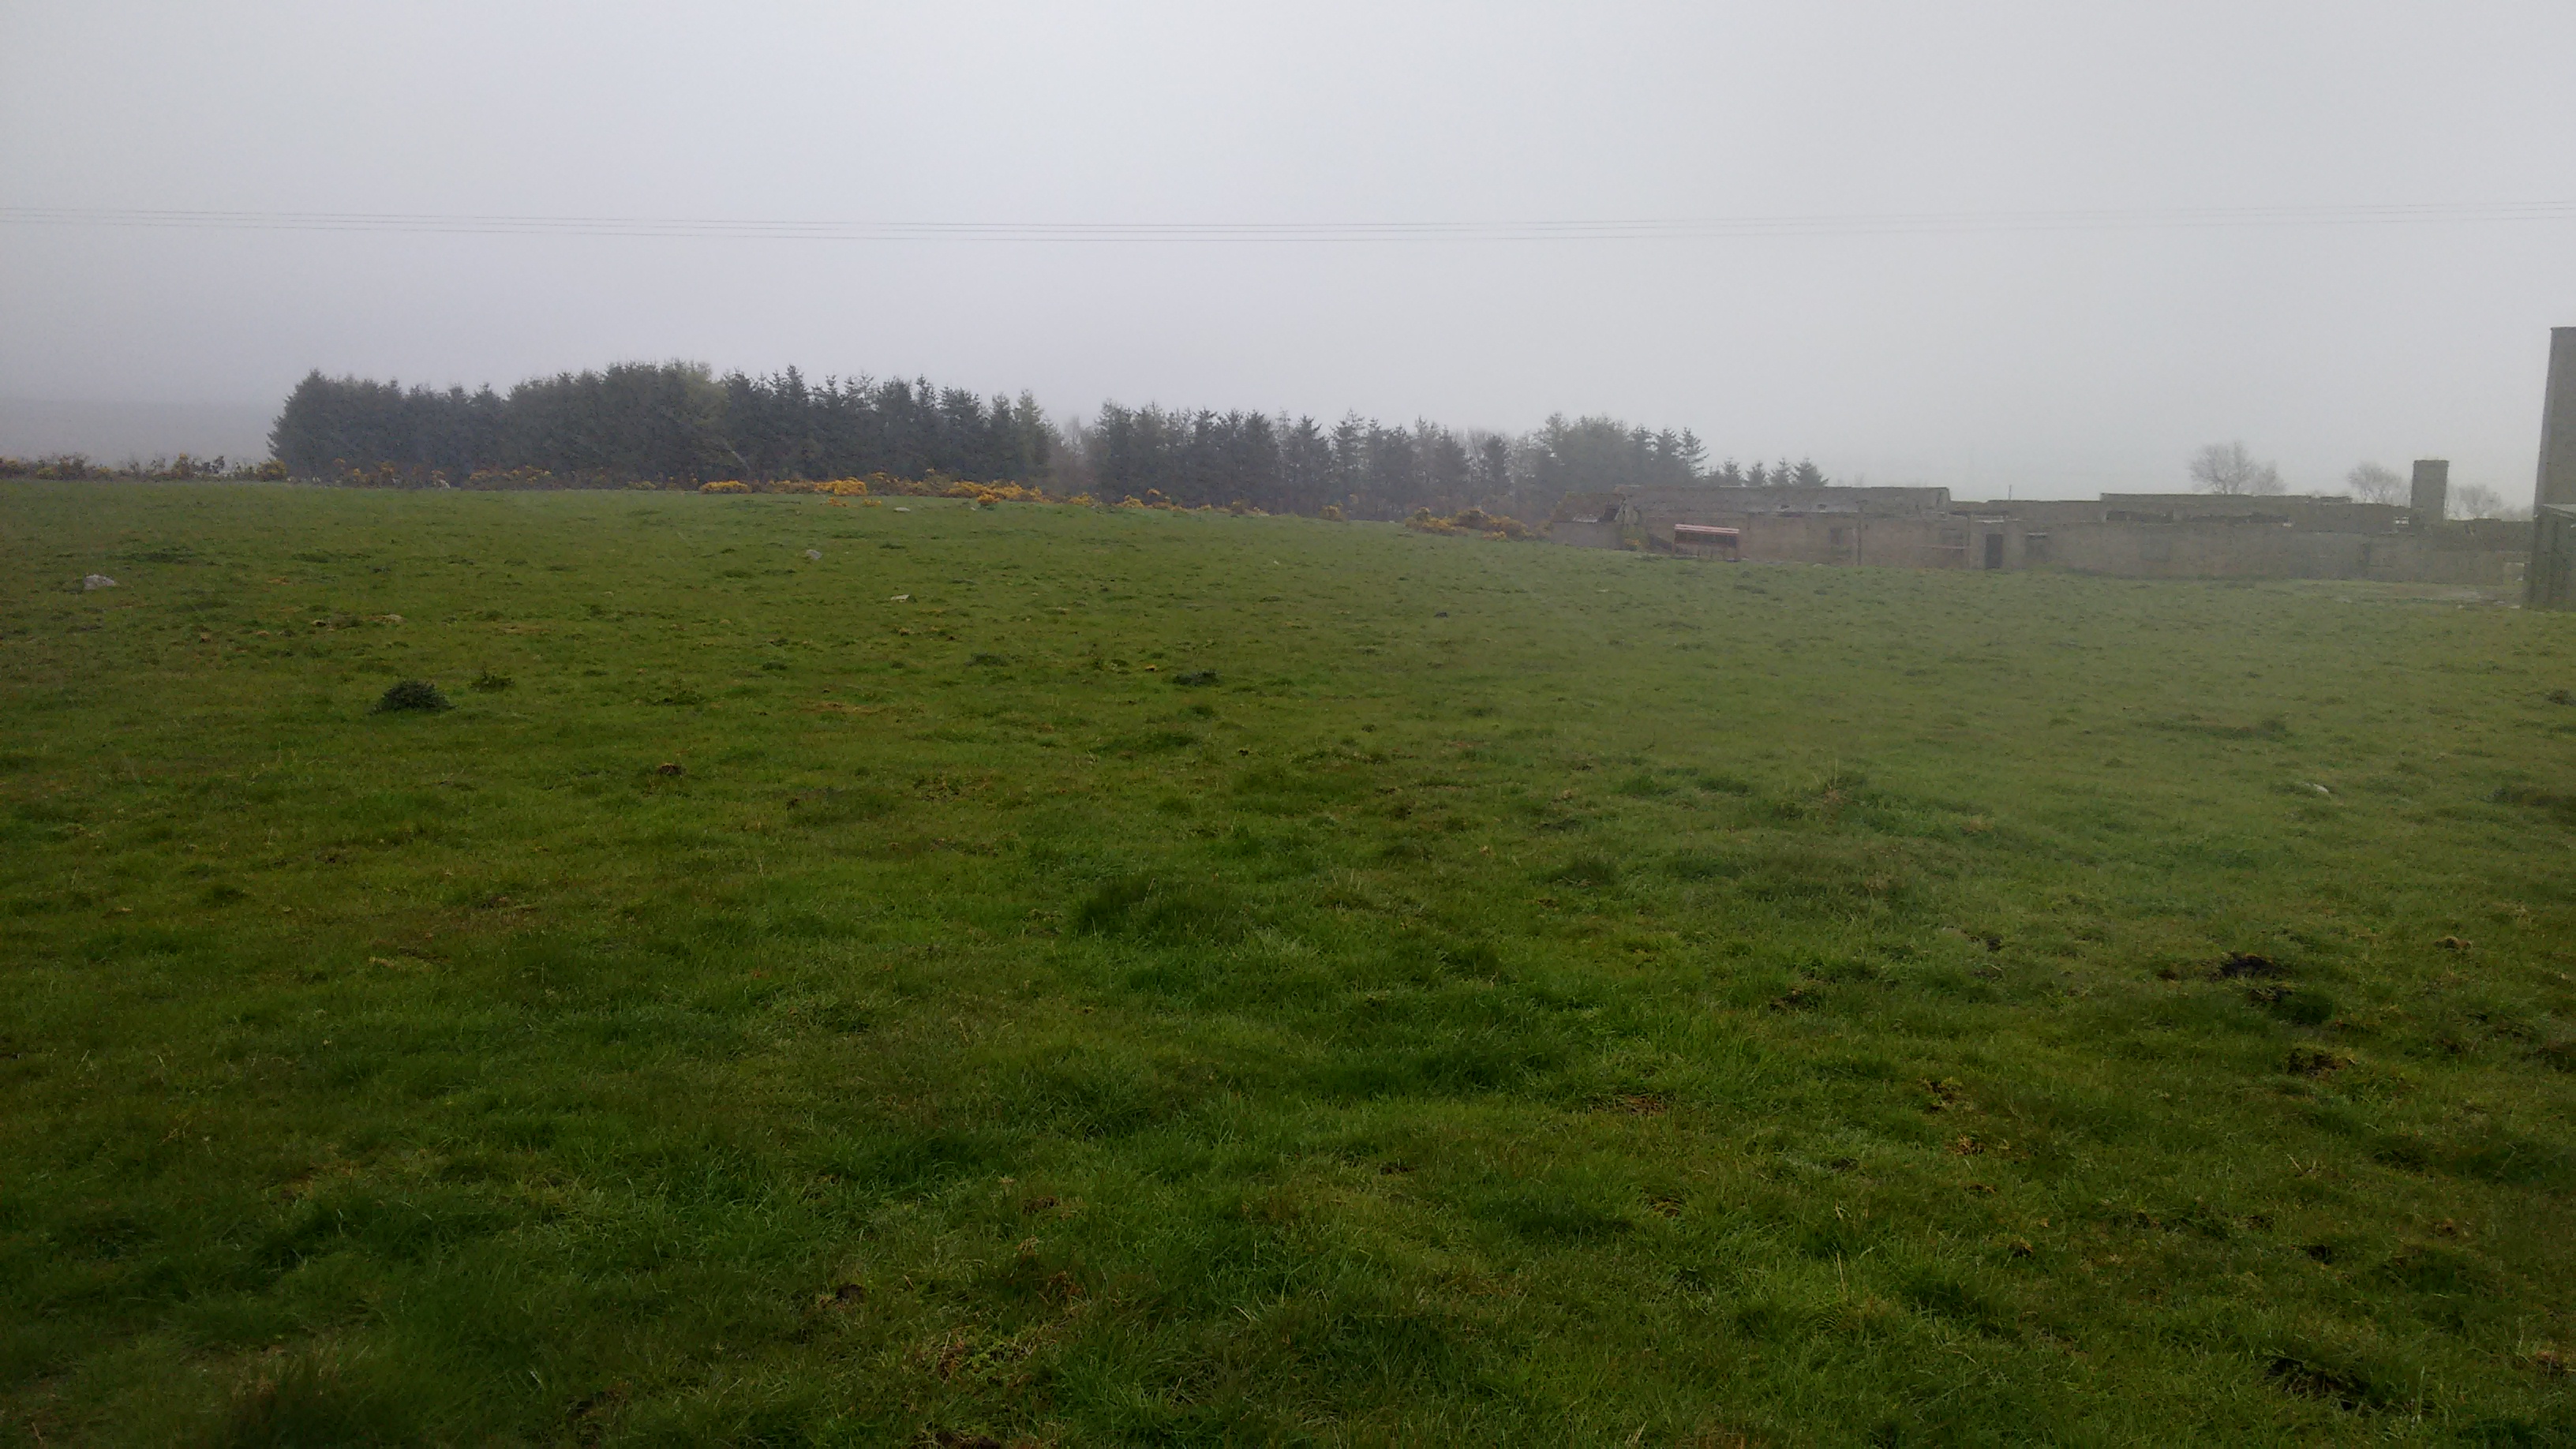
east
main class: Grassland
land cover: Grassland without tree/shrub cover
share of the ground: > 75 %
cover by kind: herbaceous plants 100 %
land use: Agriculture (excluding fallow land and kitchen gardens)
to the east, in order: Grassland without tree/shrub cover; Electric lines; Shrubland without tree cover; Grassland without tree/shrub cover; Shrubland without tree cover; Fences; Spruce dominated mixed woodland; Fences; Grass margins; Artificial constructions in urban areas; Grassland without tree/shrub cover; Fences; Electric lines; Grass margins; Tracks
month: May
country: GB
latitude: 56.5447
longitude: -2.9958
